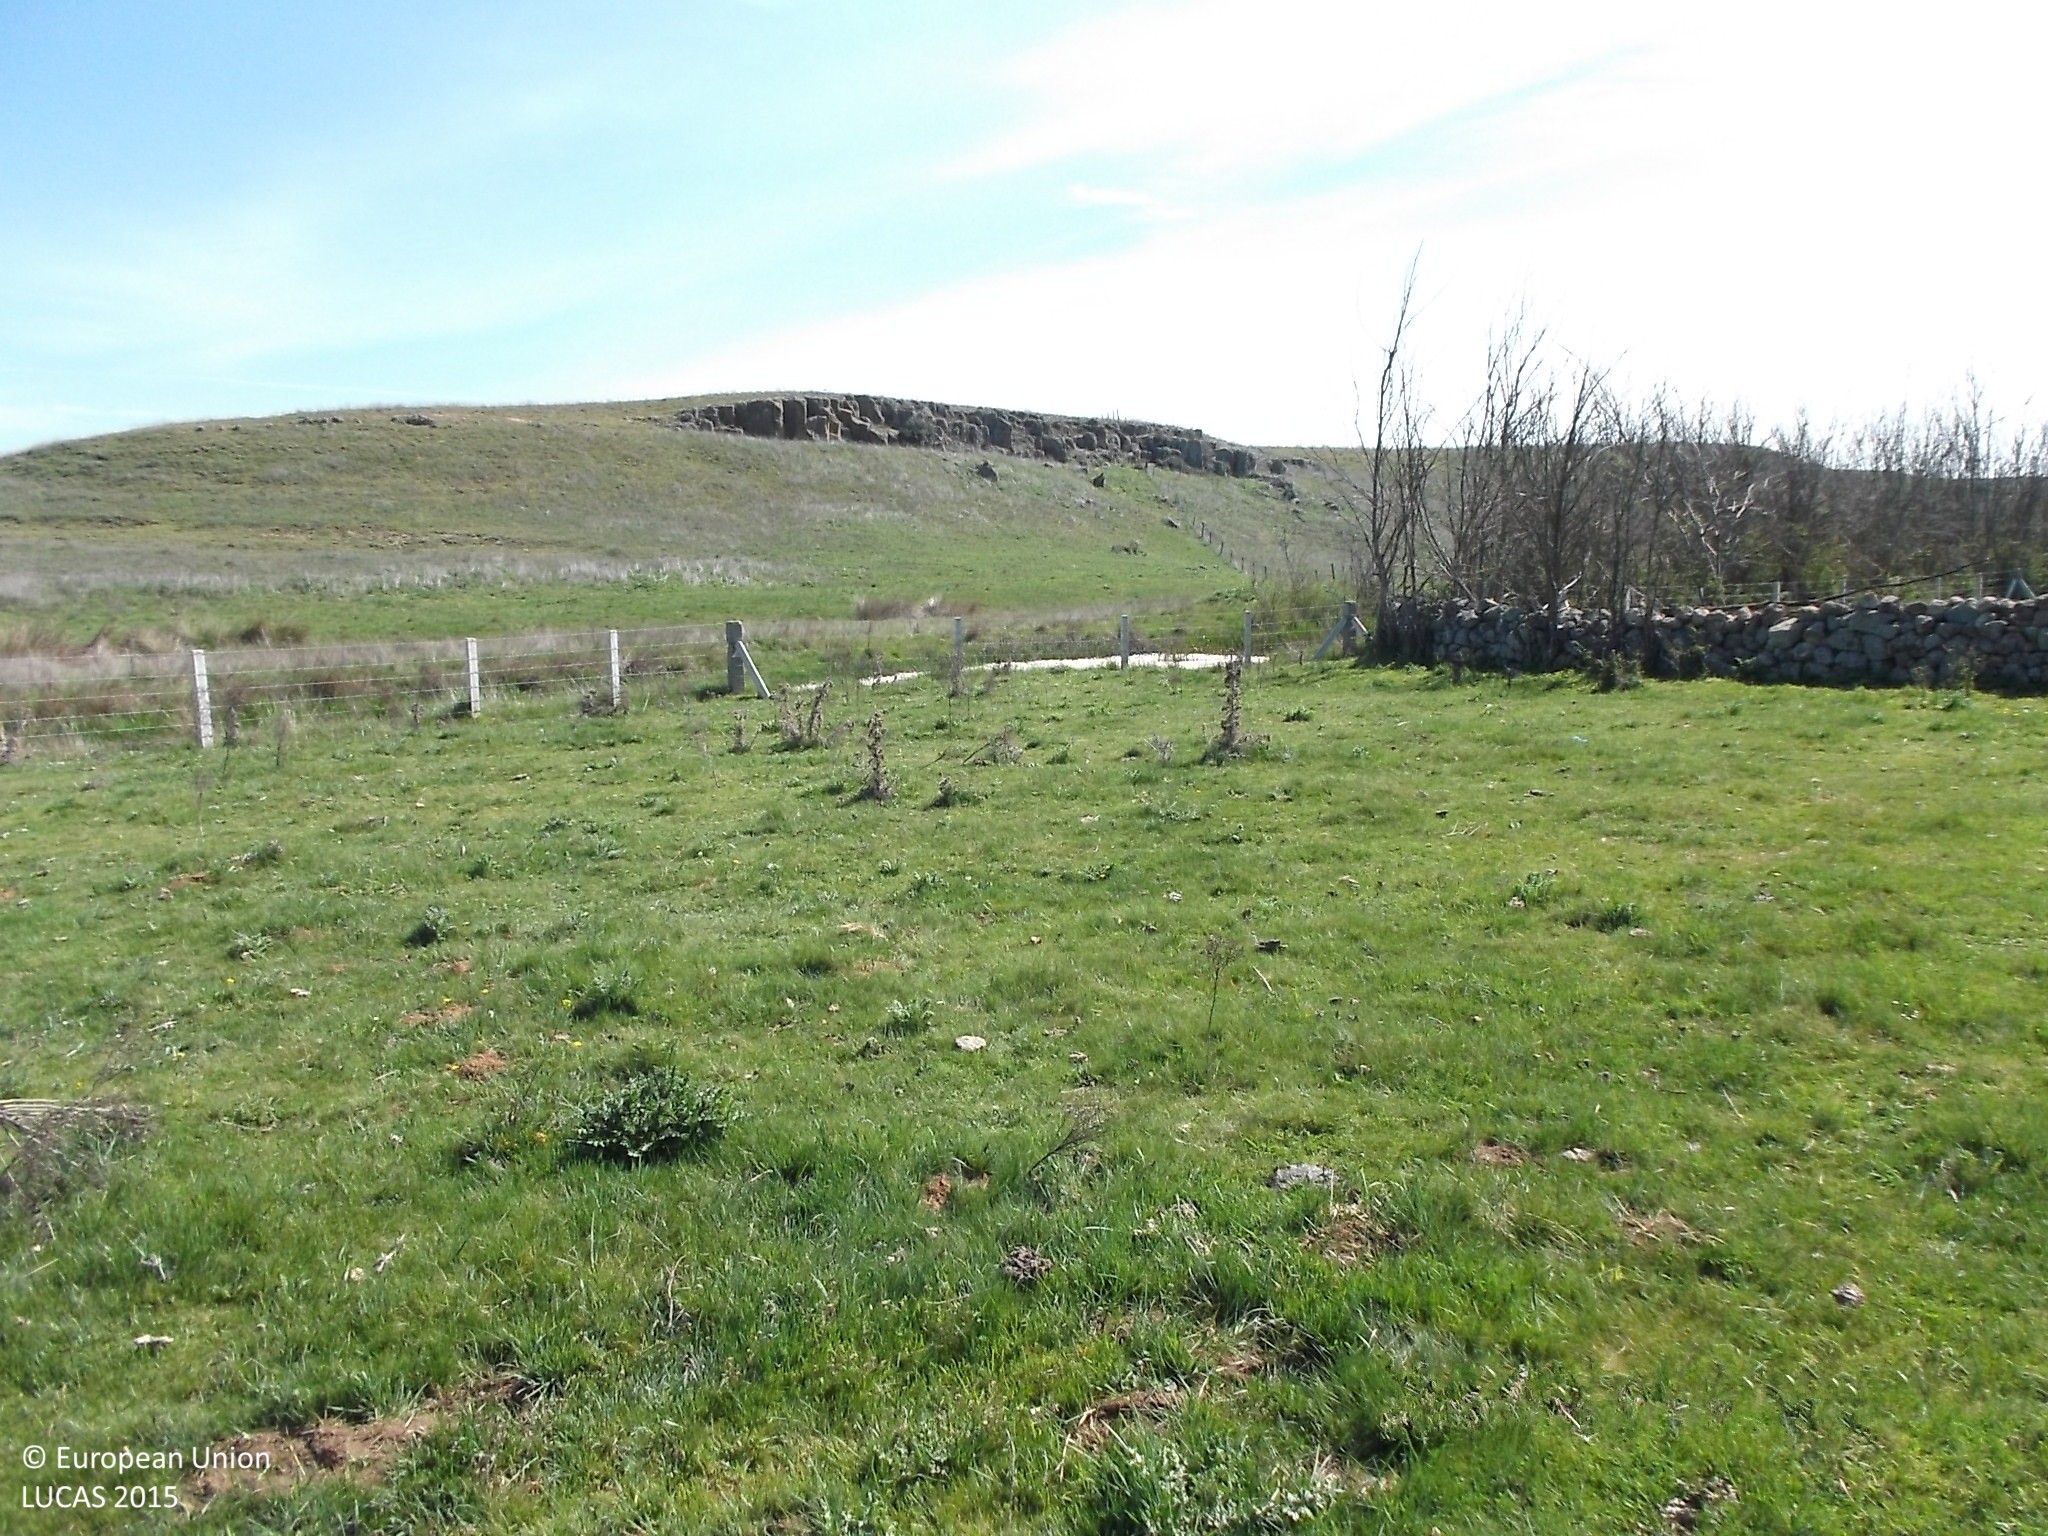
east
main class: Grassland
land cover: Grassland without tree/shrub cover
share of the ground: > 75 %
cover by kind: herbaceous plants 100 %
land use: Agriculture (excluding fallow land and kitchen gardens)
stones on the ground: < 10 %
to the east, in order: Grassland without tree/shrub cover; Dry stone walls; Groves; Grassland without tree/shrub cover; Groves; Grassland without tree/shrub cover; Fences; Rivers and streams; Fences; Grassland without tree/shrub cover; Fences; Grassland without tree/shrub cover
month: April
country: ES
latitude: 40.9664
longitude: -5.8975
